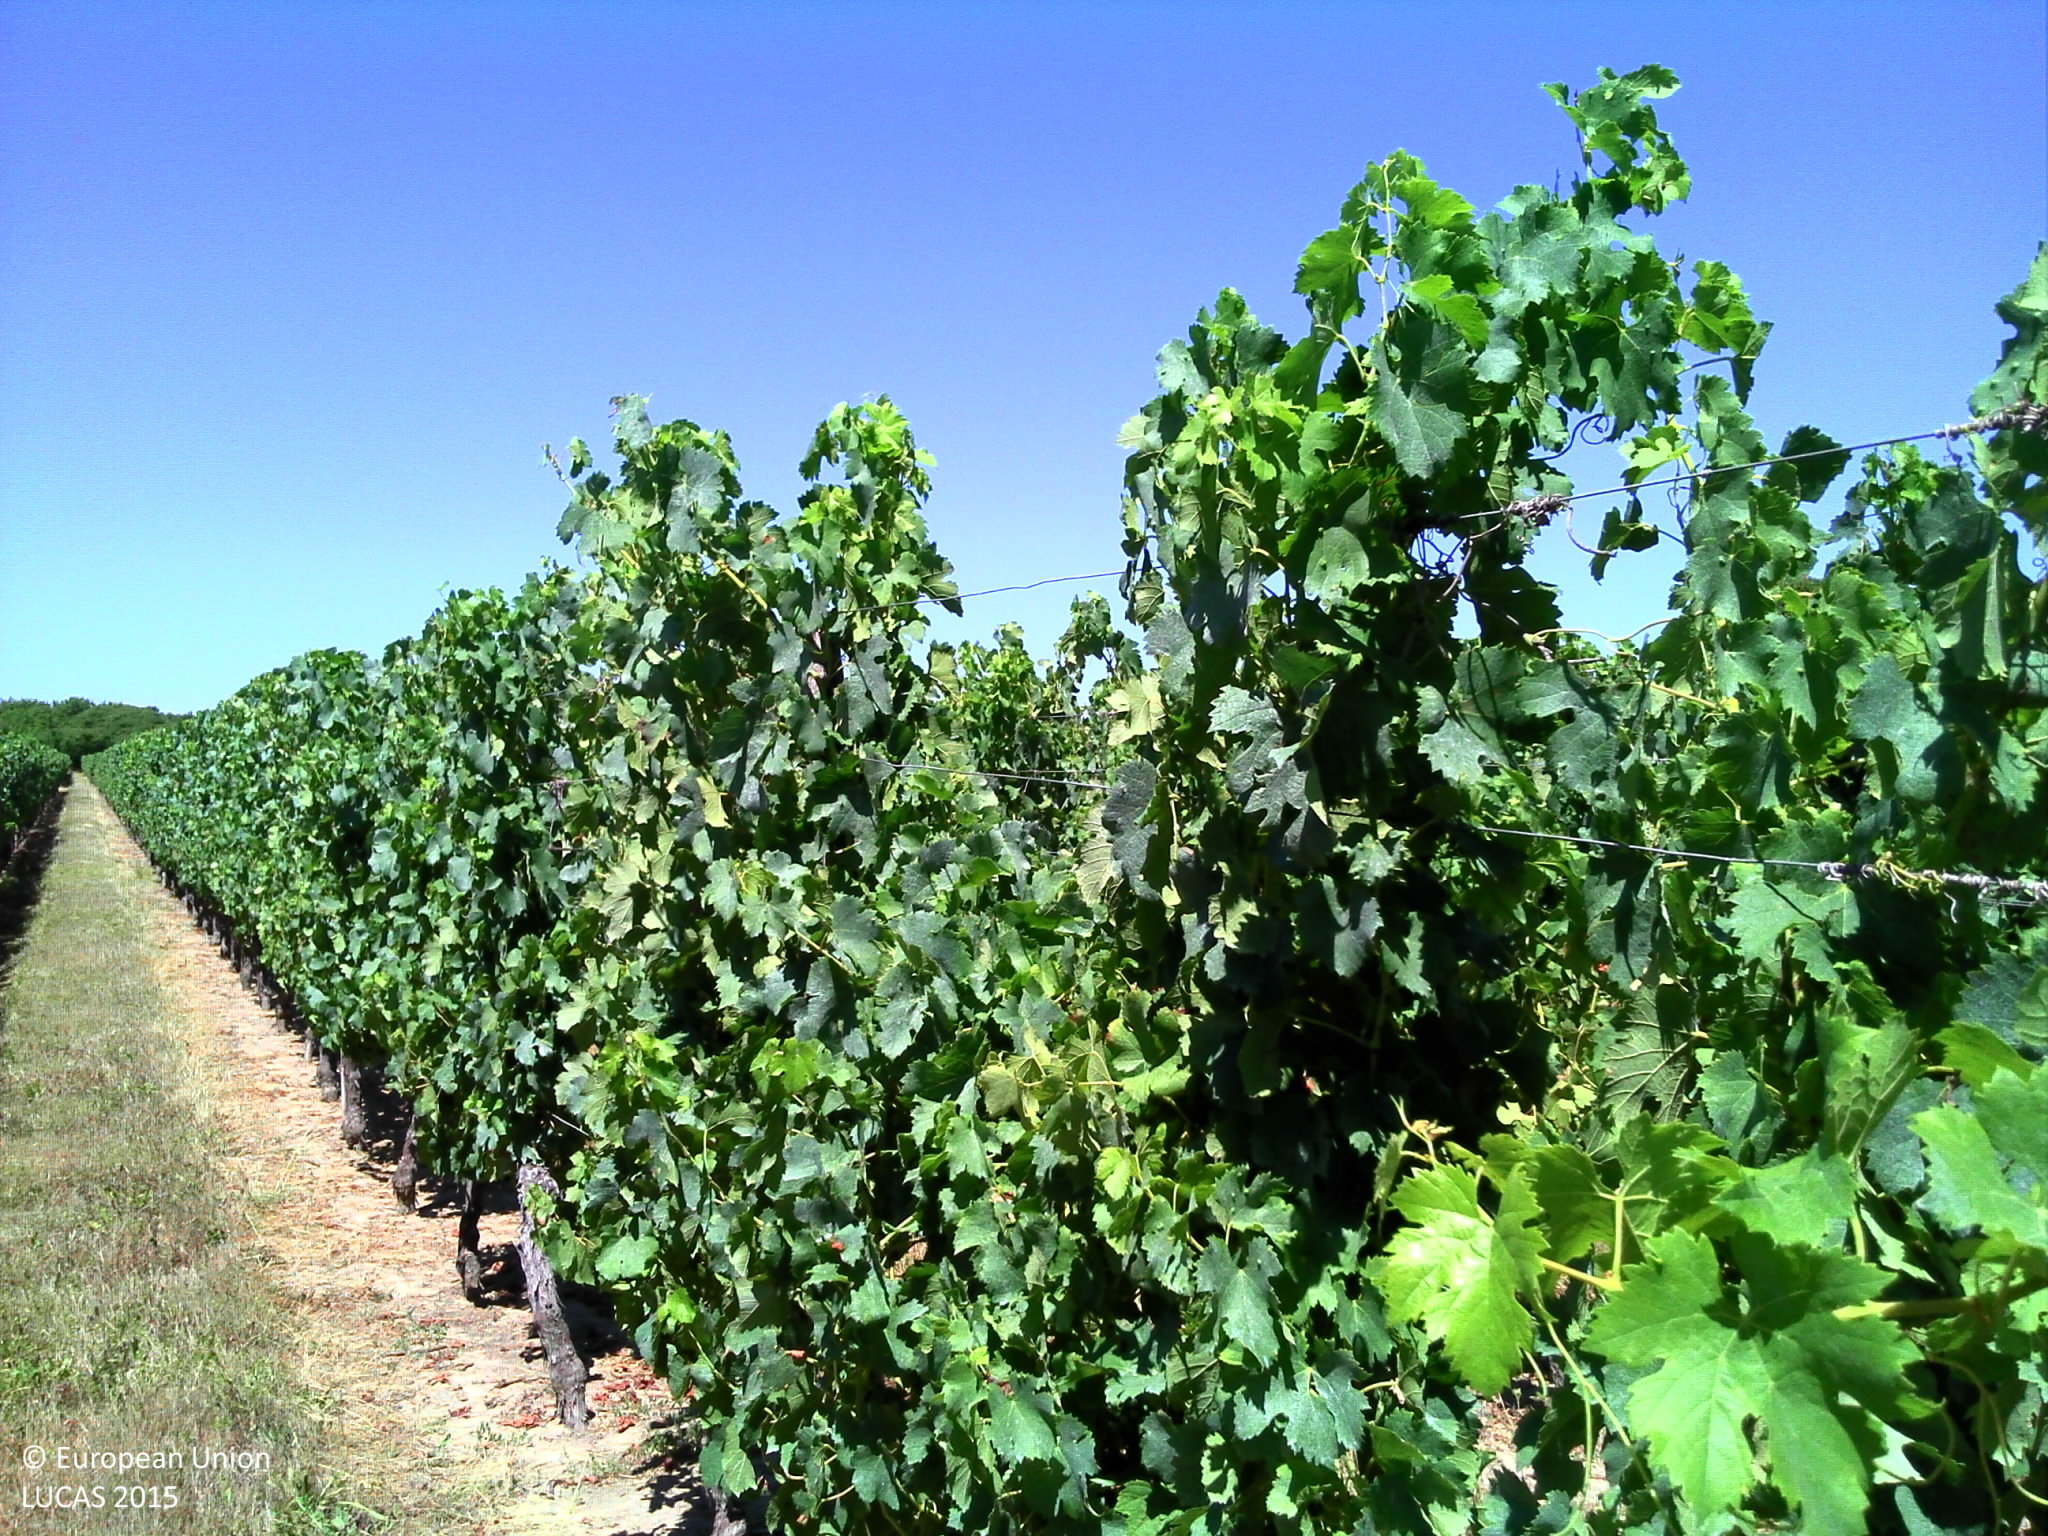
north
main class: Cropland
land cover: Vineyards
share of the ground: 25 - 50 %
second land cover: Grassland without tree/shrub cover
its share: > 75 %
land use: Agriculture (excluding fallow land and kitchen gardens)
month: July
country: FR
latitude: 44.8205
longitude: 0.4929
